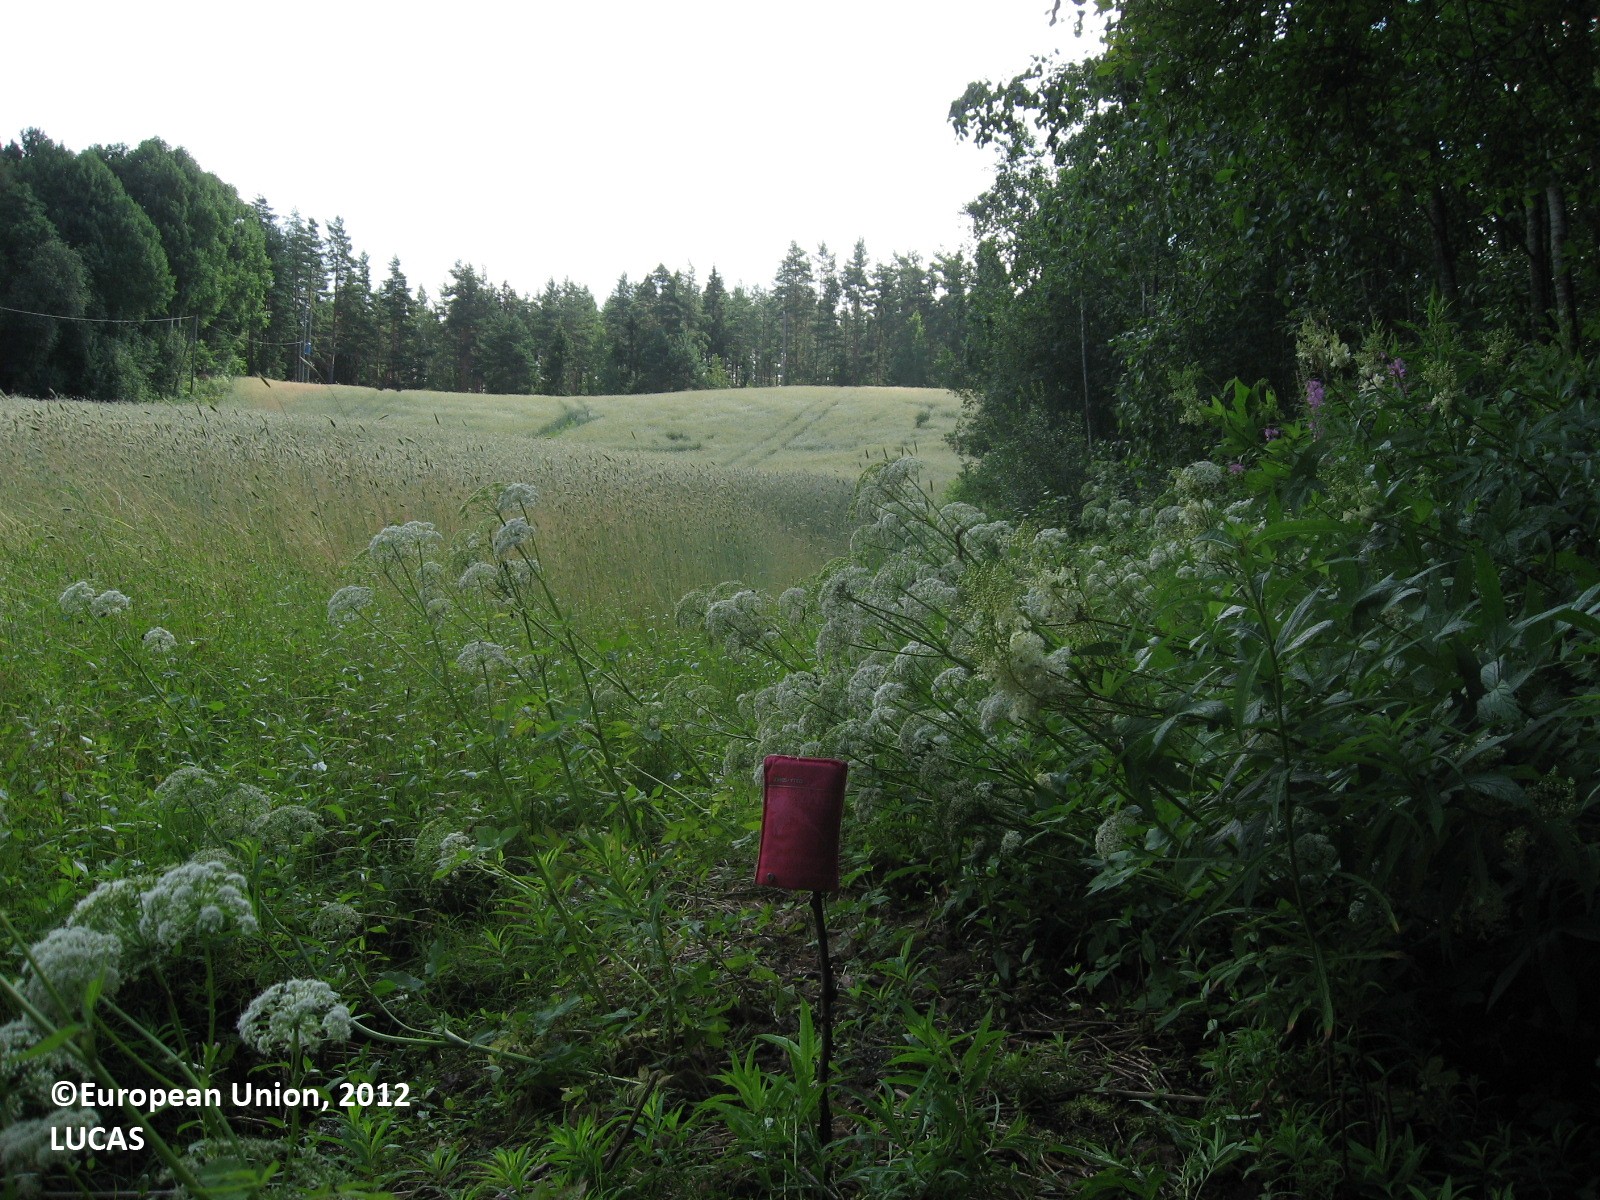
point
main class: Shrubland
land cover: Shrubland with sparse tree cover
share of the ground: > 75 %
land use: Semi-natural and natural areas not in use
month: July
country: FI
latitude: 61.1382
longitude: 25.6729
